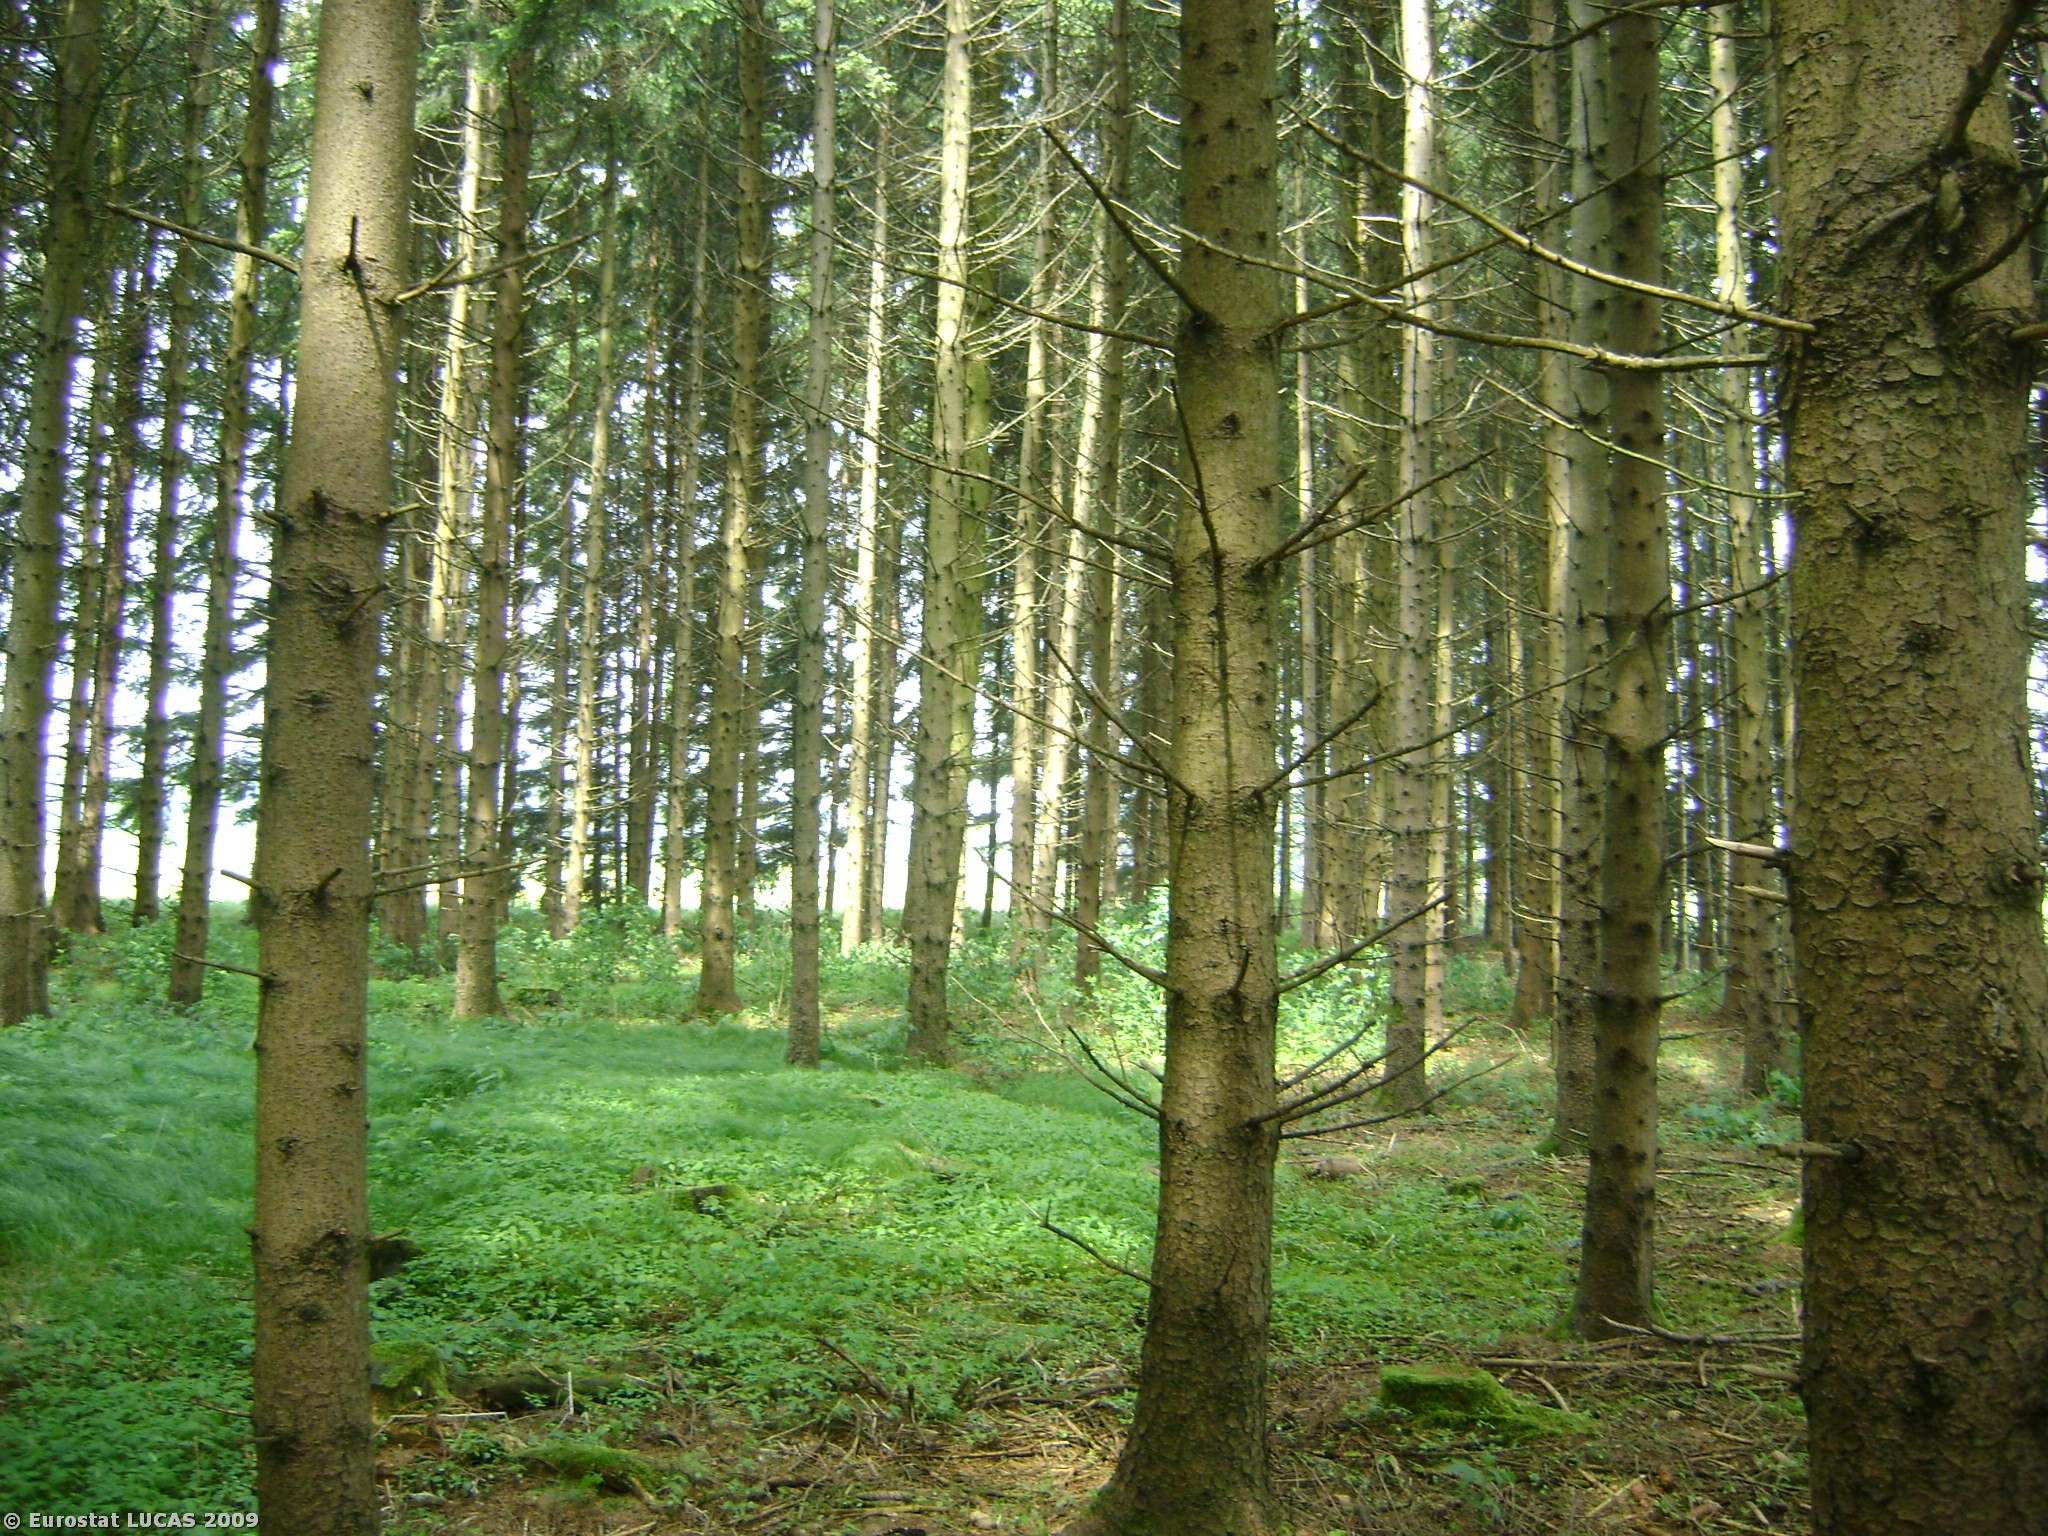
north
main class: Woodland
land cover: Coniferous woodland
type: hemiboreal forest and nemoral coniferous forest and mixed broadleaved-coniferous forest
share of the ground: > 75 %
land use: Forestry
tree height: > 5 m
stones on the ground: < 10 %
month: May
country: AT
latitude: 47.9782
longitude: 13.2275
